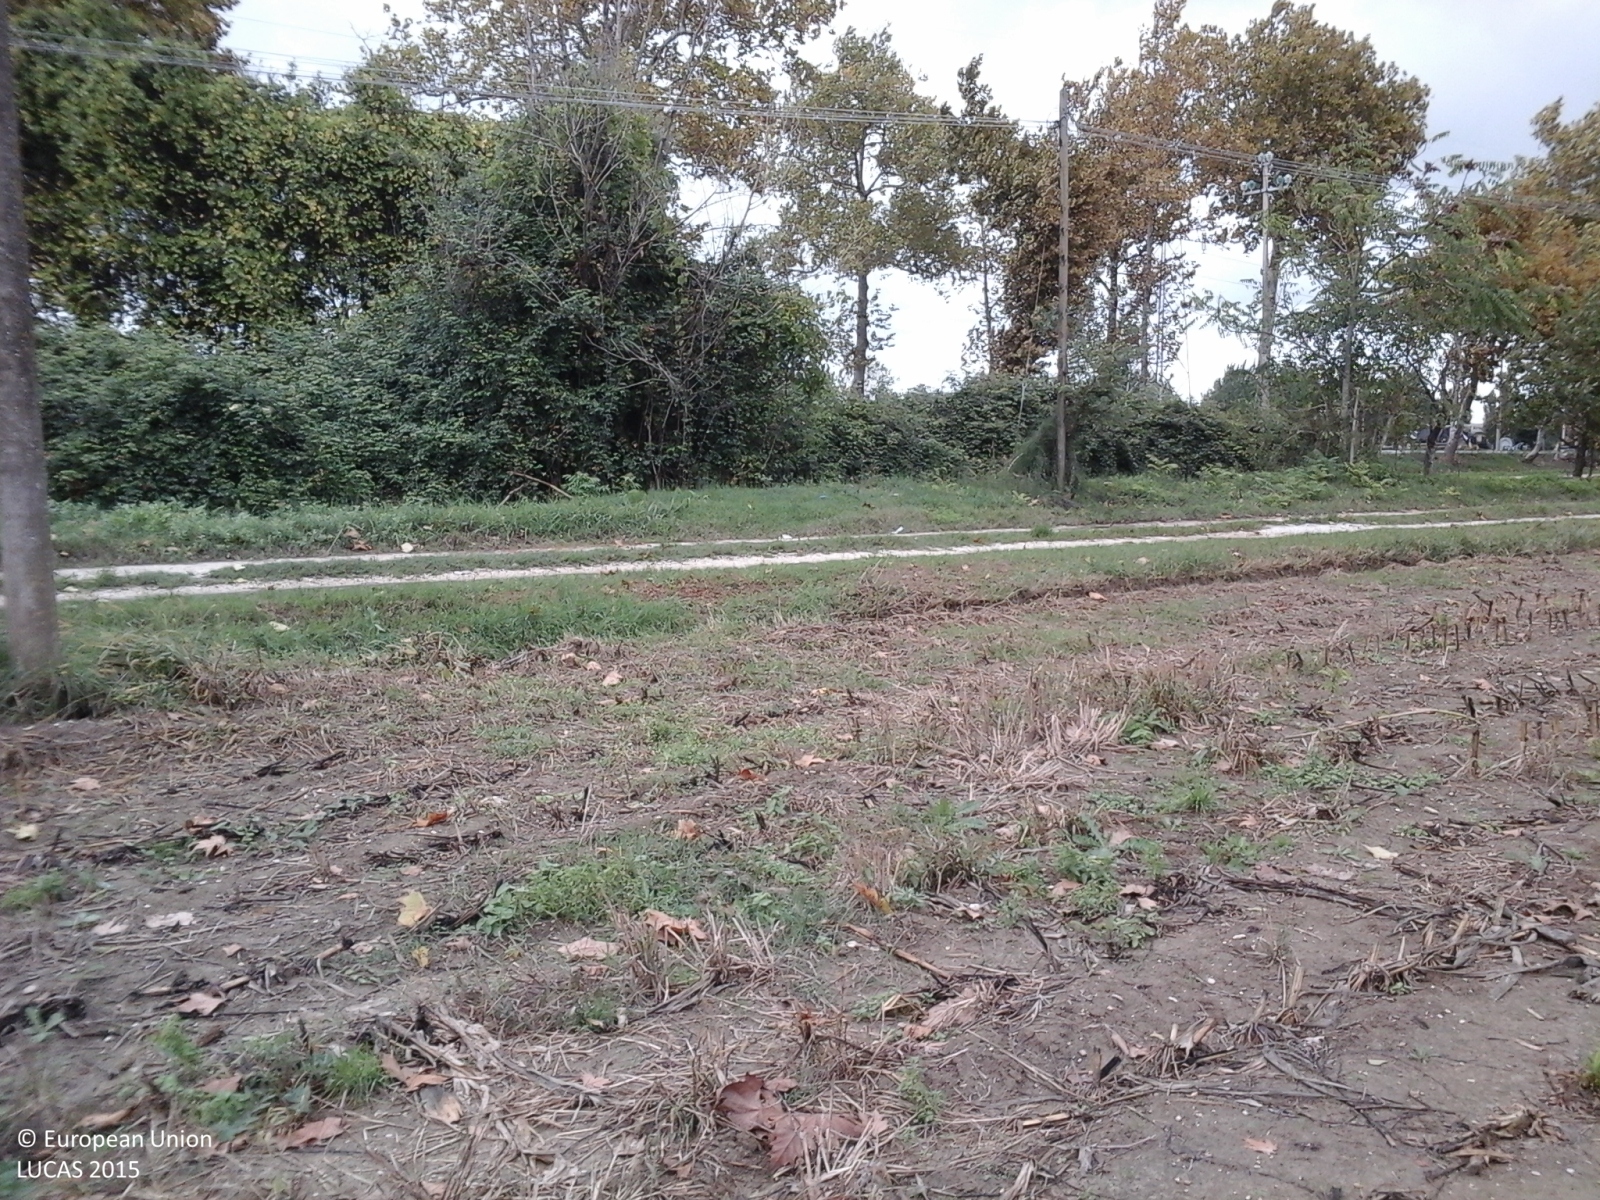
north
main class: Cropland
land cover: Maize
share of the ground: < 10 %
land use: Agriculture (excluding fallow land and kitchen gardens)
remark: Harvested field
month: October
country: IT
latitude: 43.6284
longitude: 13.3507
